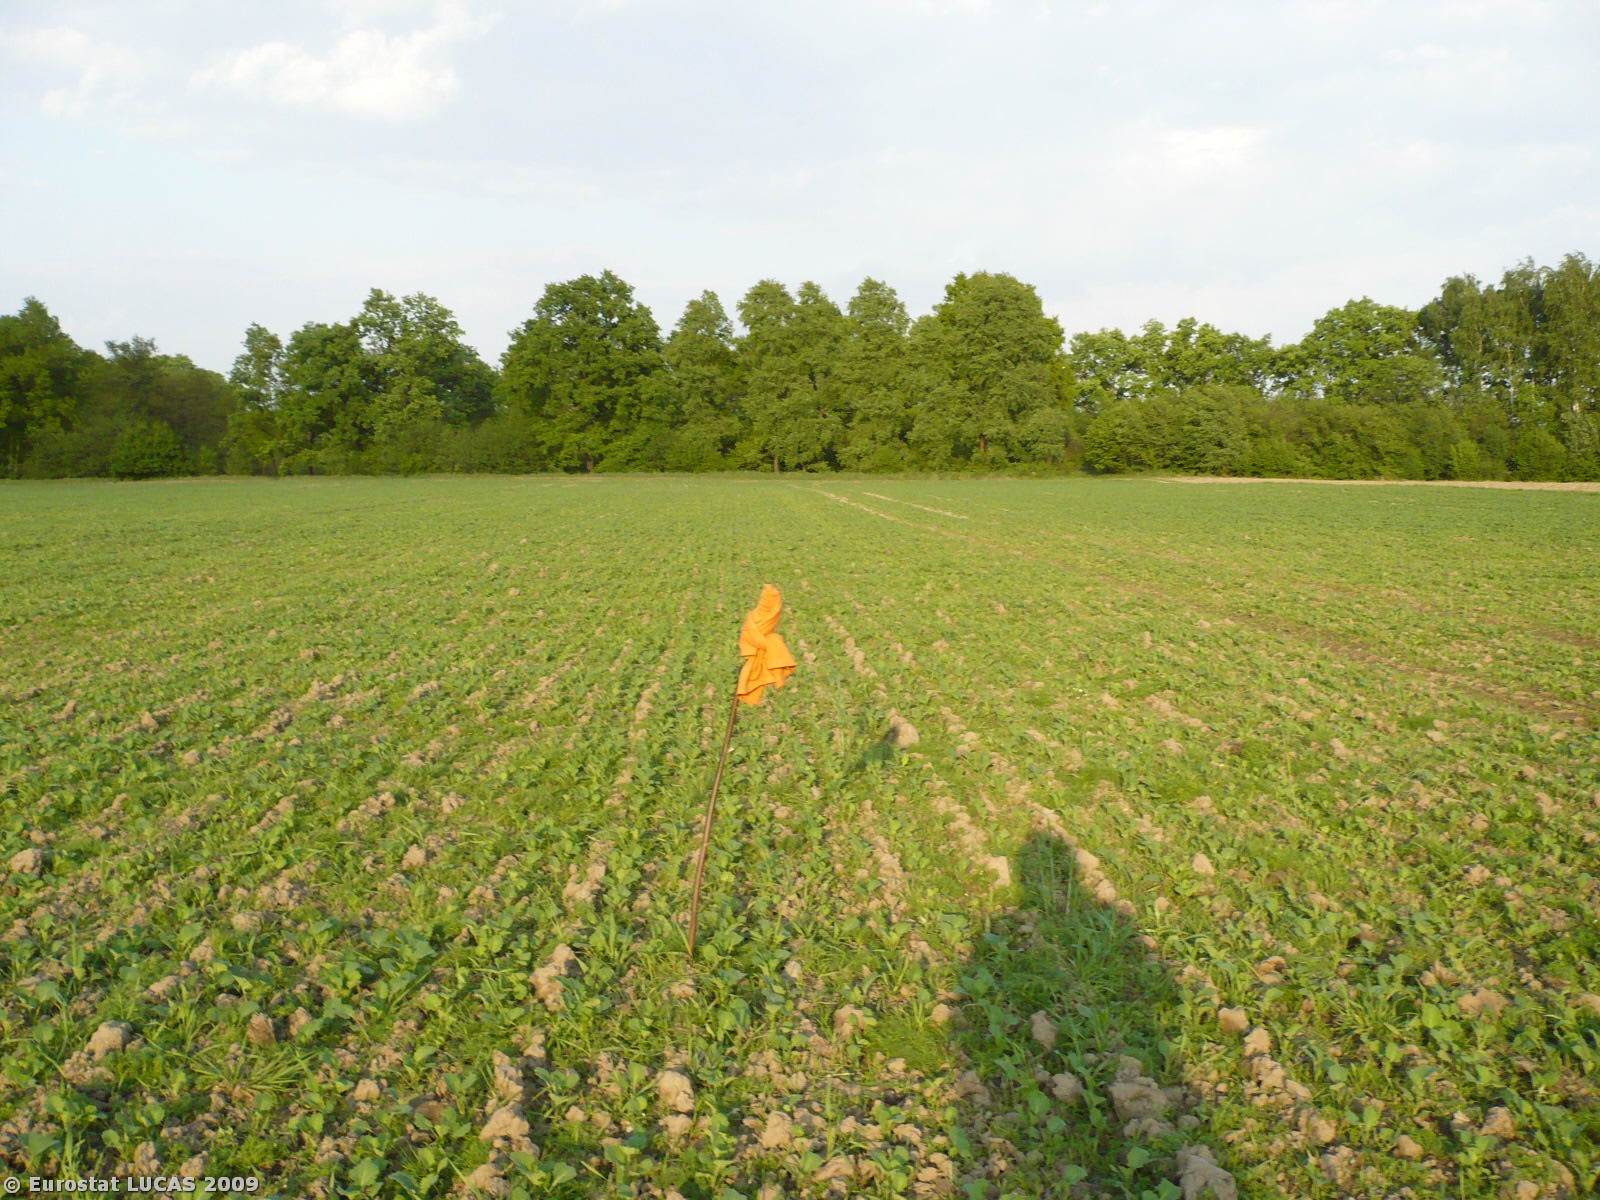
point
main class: Cropland
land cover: Sugar beet
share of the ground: 50 - 75 %
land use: Agriculture (excluding fallow land and kitchen gardens)
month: May
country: PL
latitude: 51.8985
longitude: 15.3081
